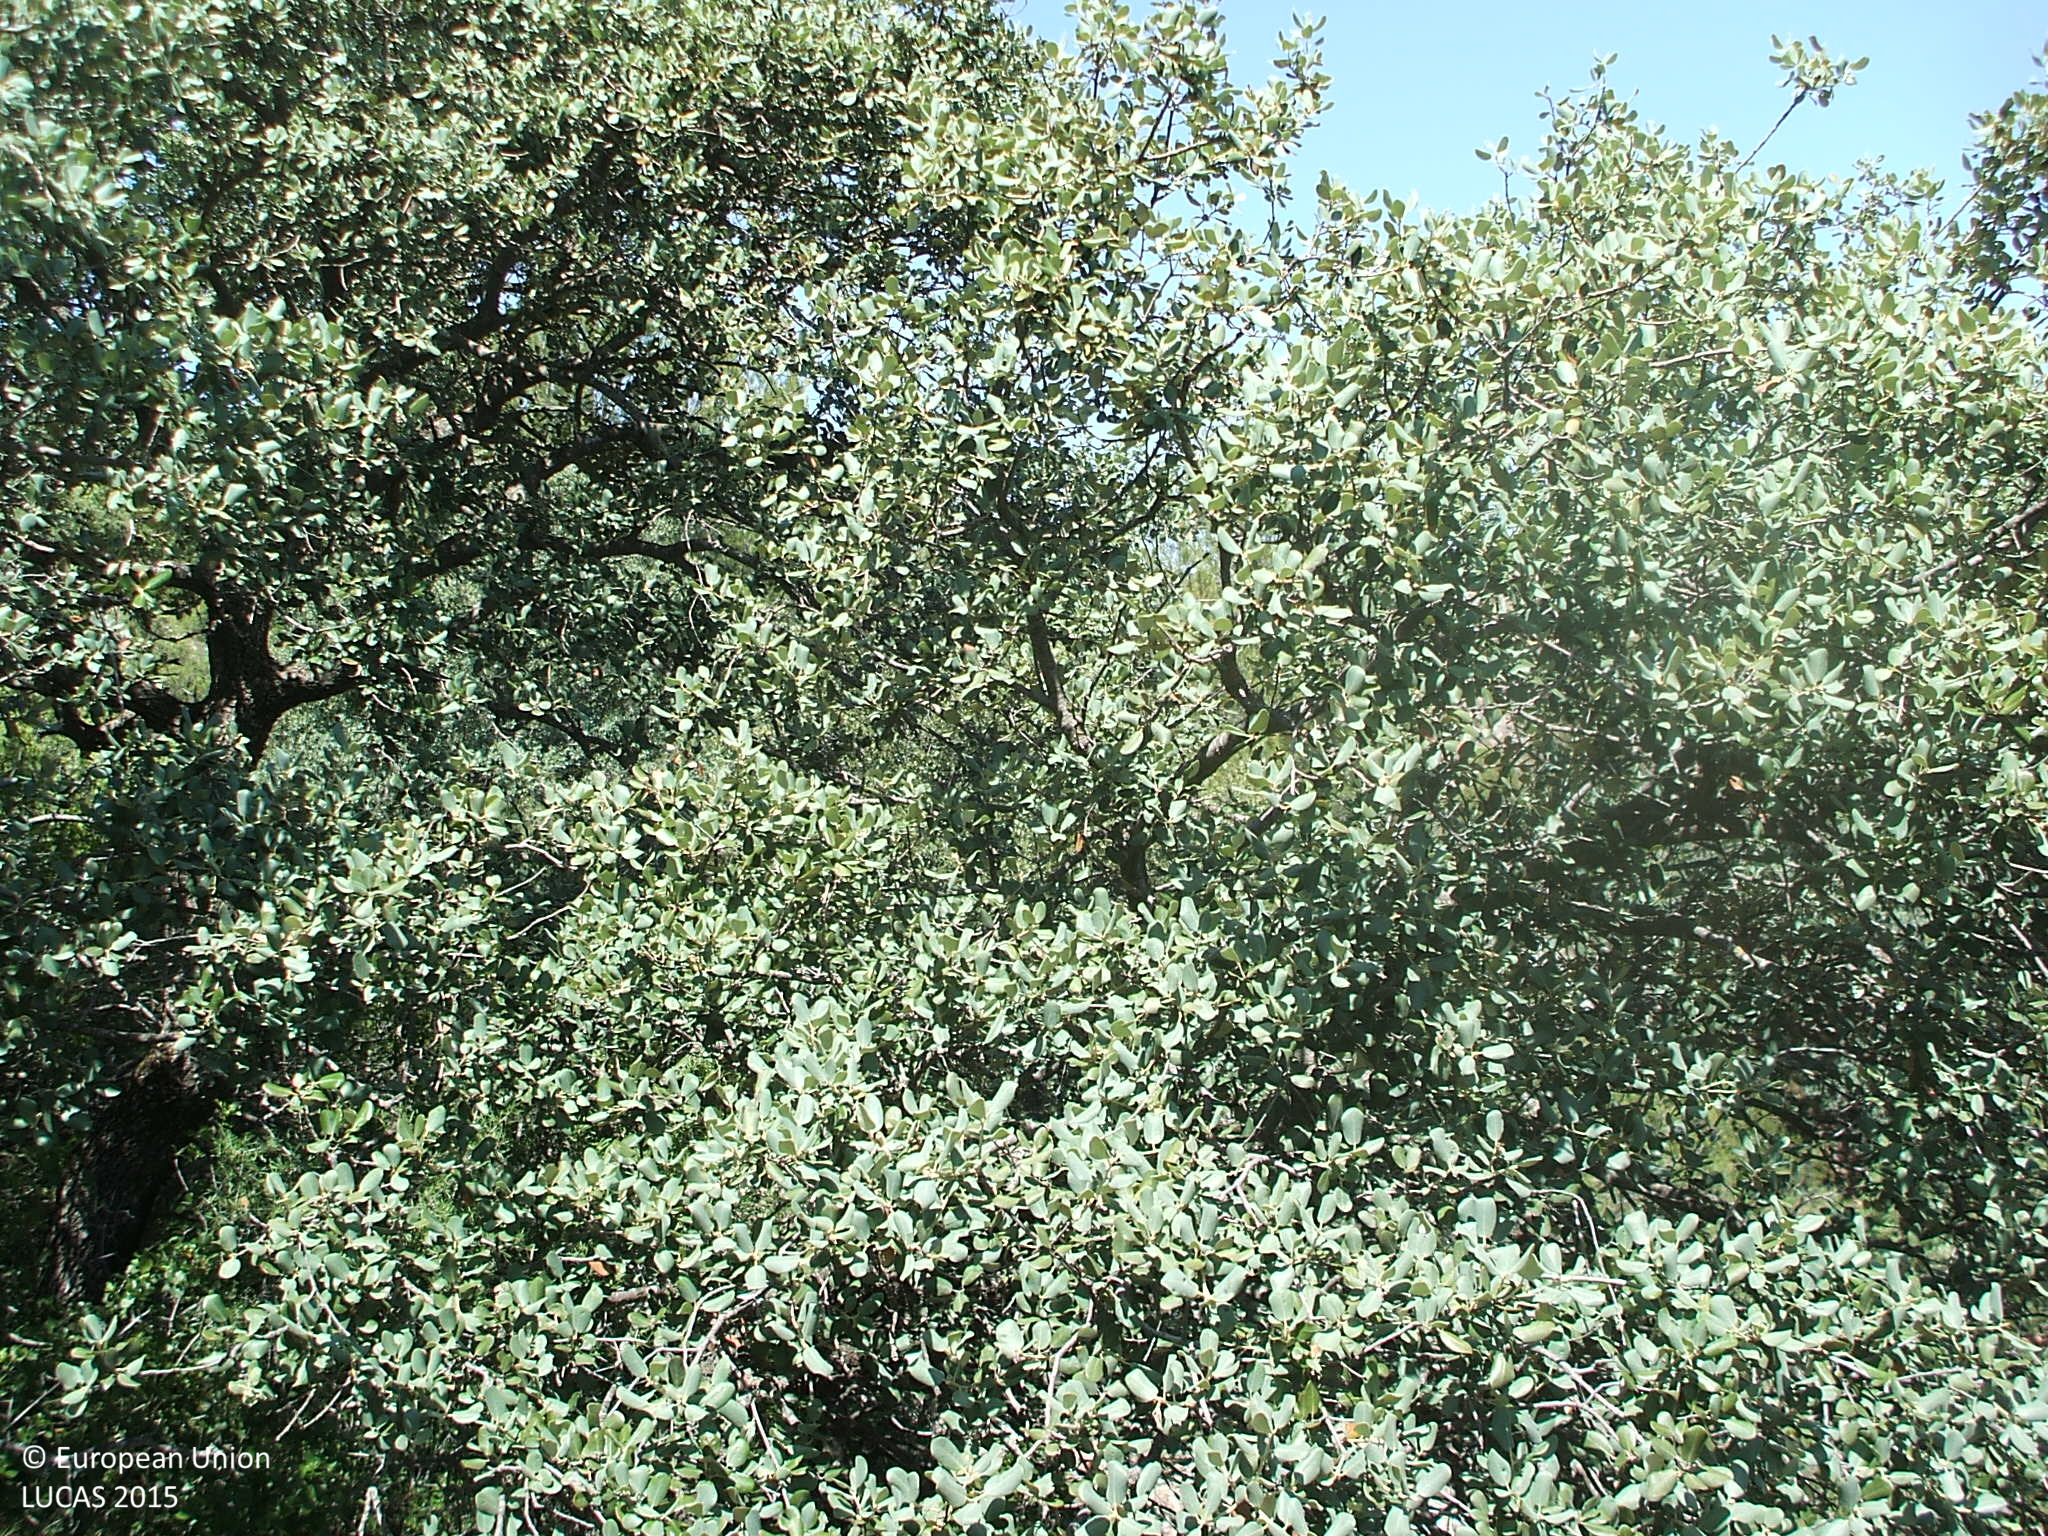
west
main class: Woodland
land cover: Other mixed woodland
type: coniferous forest of the mediterranean region
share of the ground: > 75 %
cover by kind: broadleaved forest trees 50 %, coniferous forest trees 30 %, shrubs 20 %
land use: Semi-natural and natural areas not in use
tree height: > 5 m
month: June
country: ES
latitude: 40.8539
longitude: -0.2952
